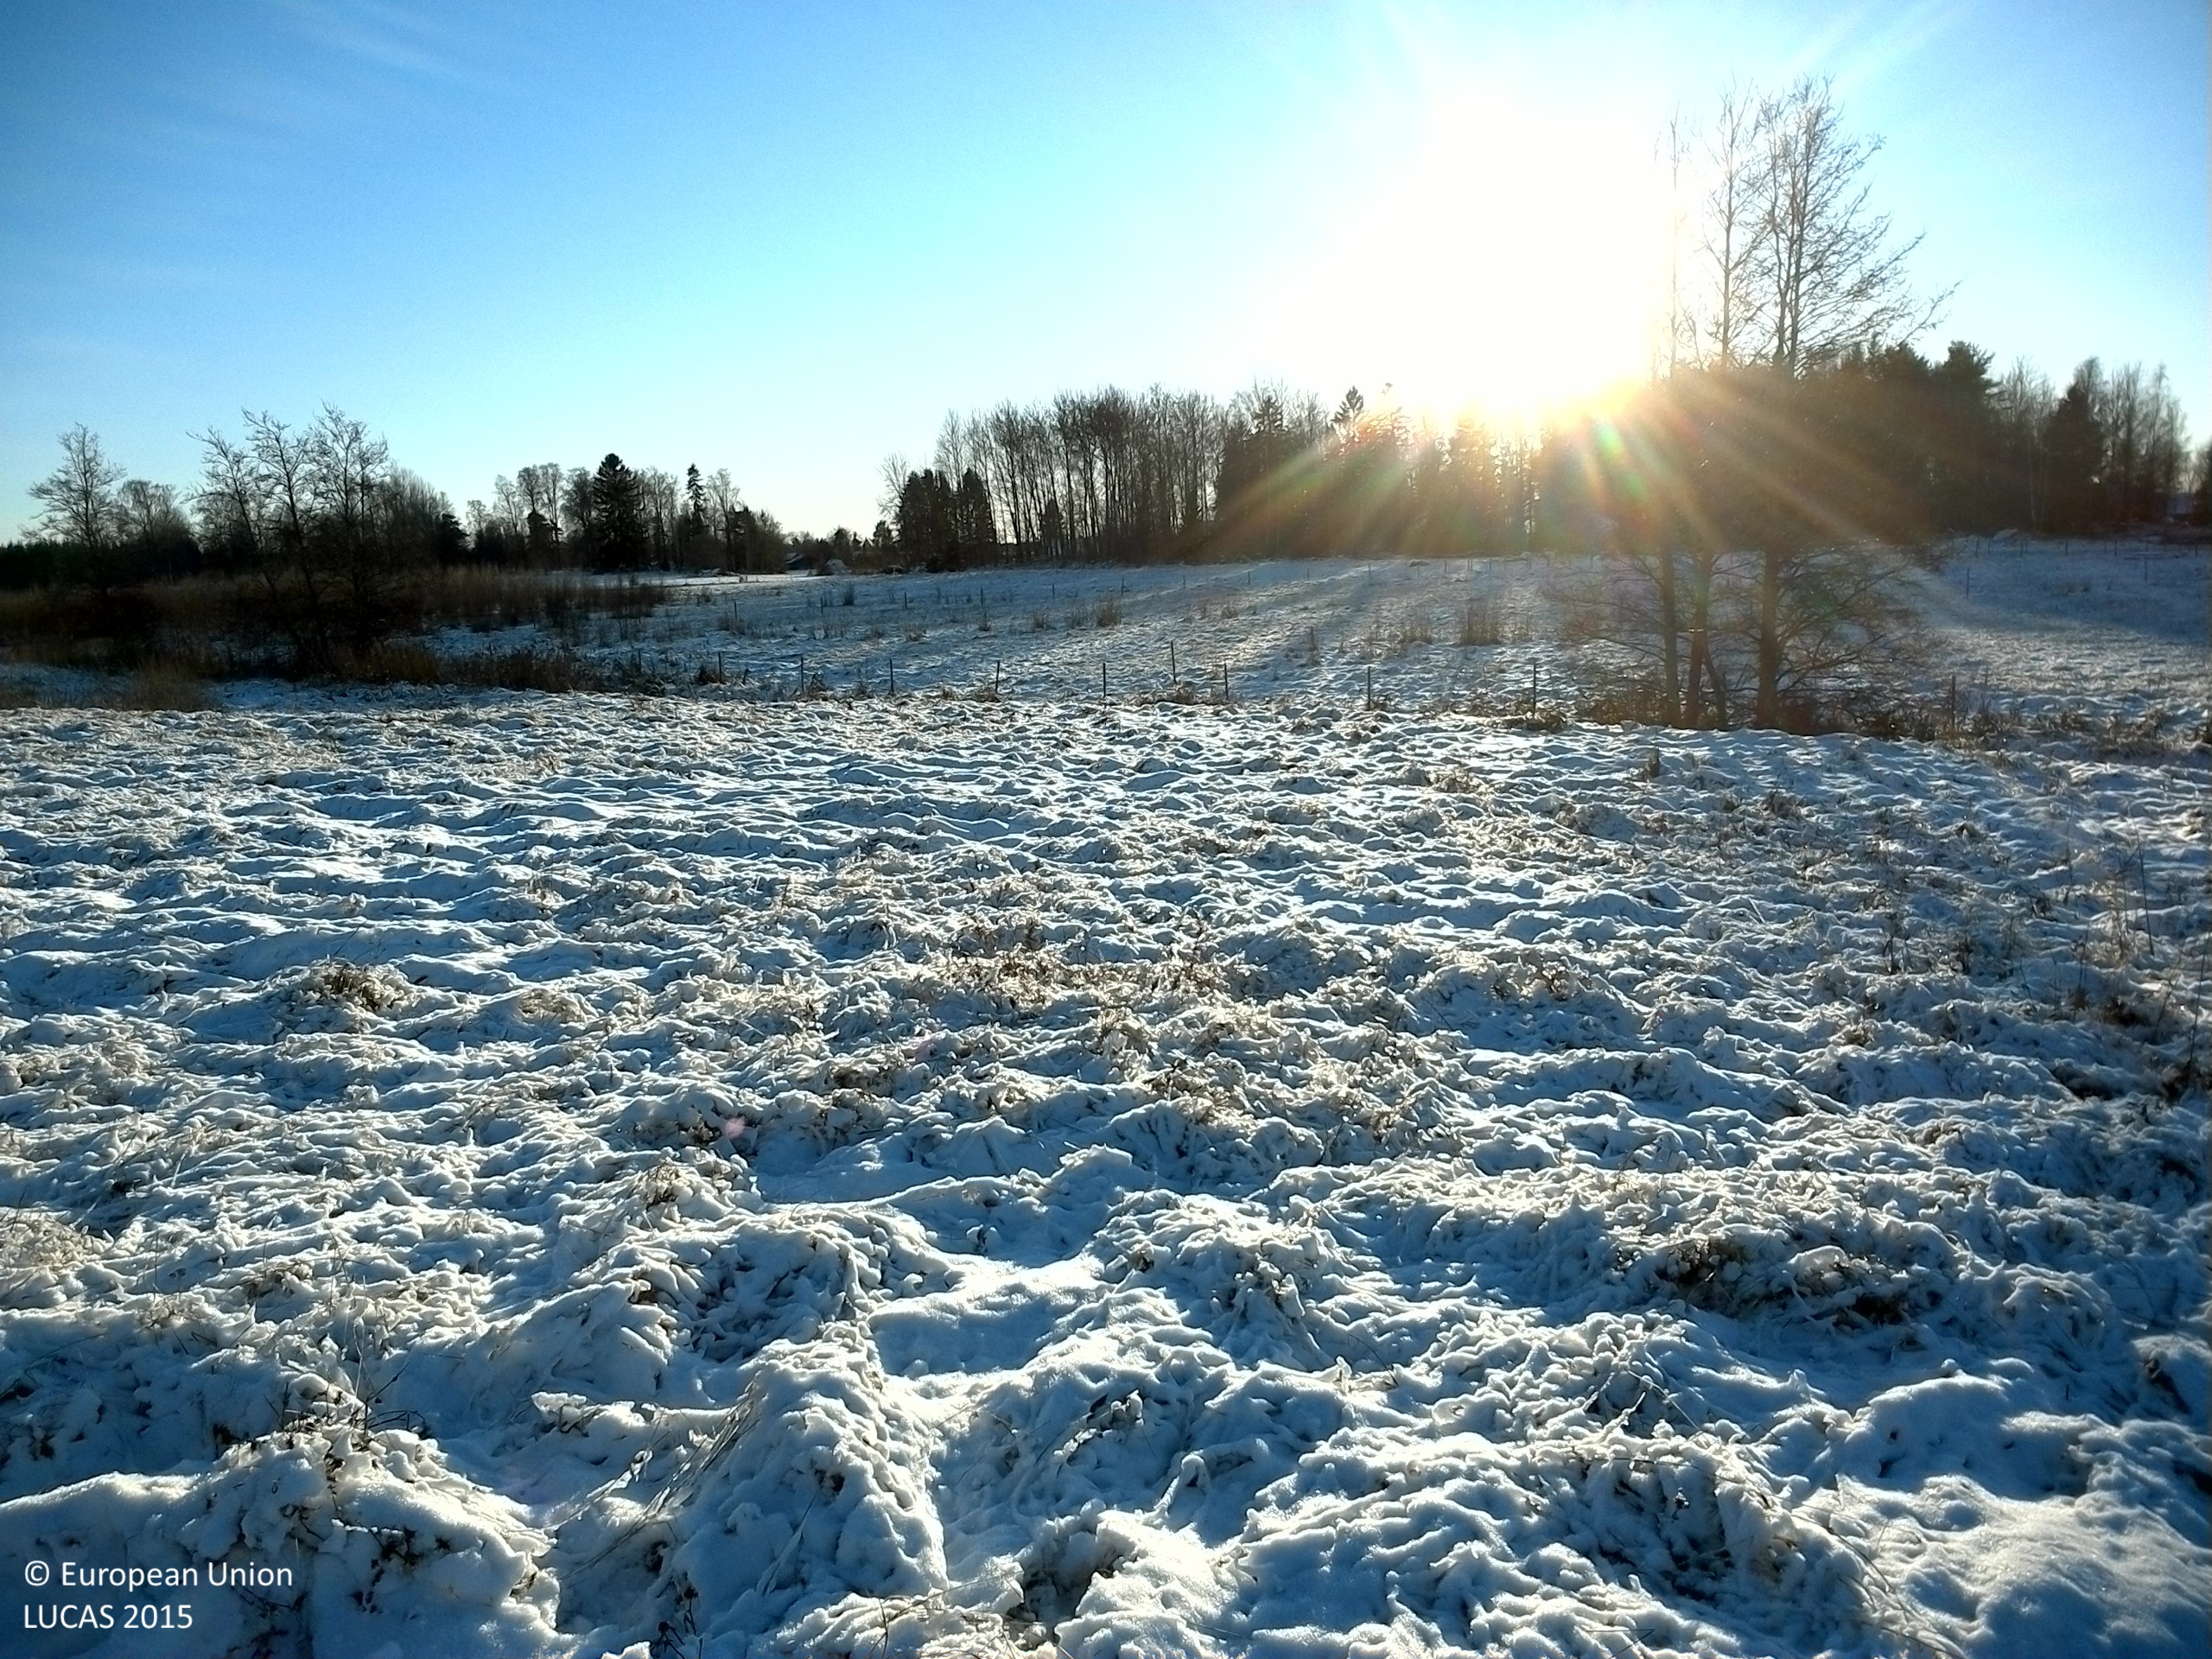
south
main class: Grassland
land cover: Grassland without tree/shrub cover
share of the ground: > 75 %
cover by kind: herbaceous plants 100 %
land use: Agriculture (excluding fallow land and kitchen gardens)
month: December
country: SE
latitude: 59.6578
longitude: 16.3629
